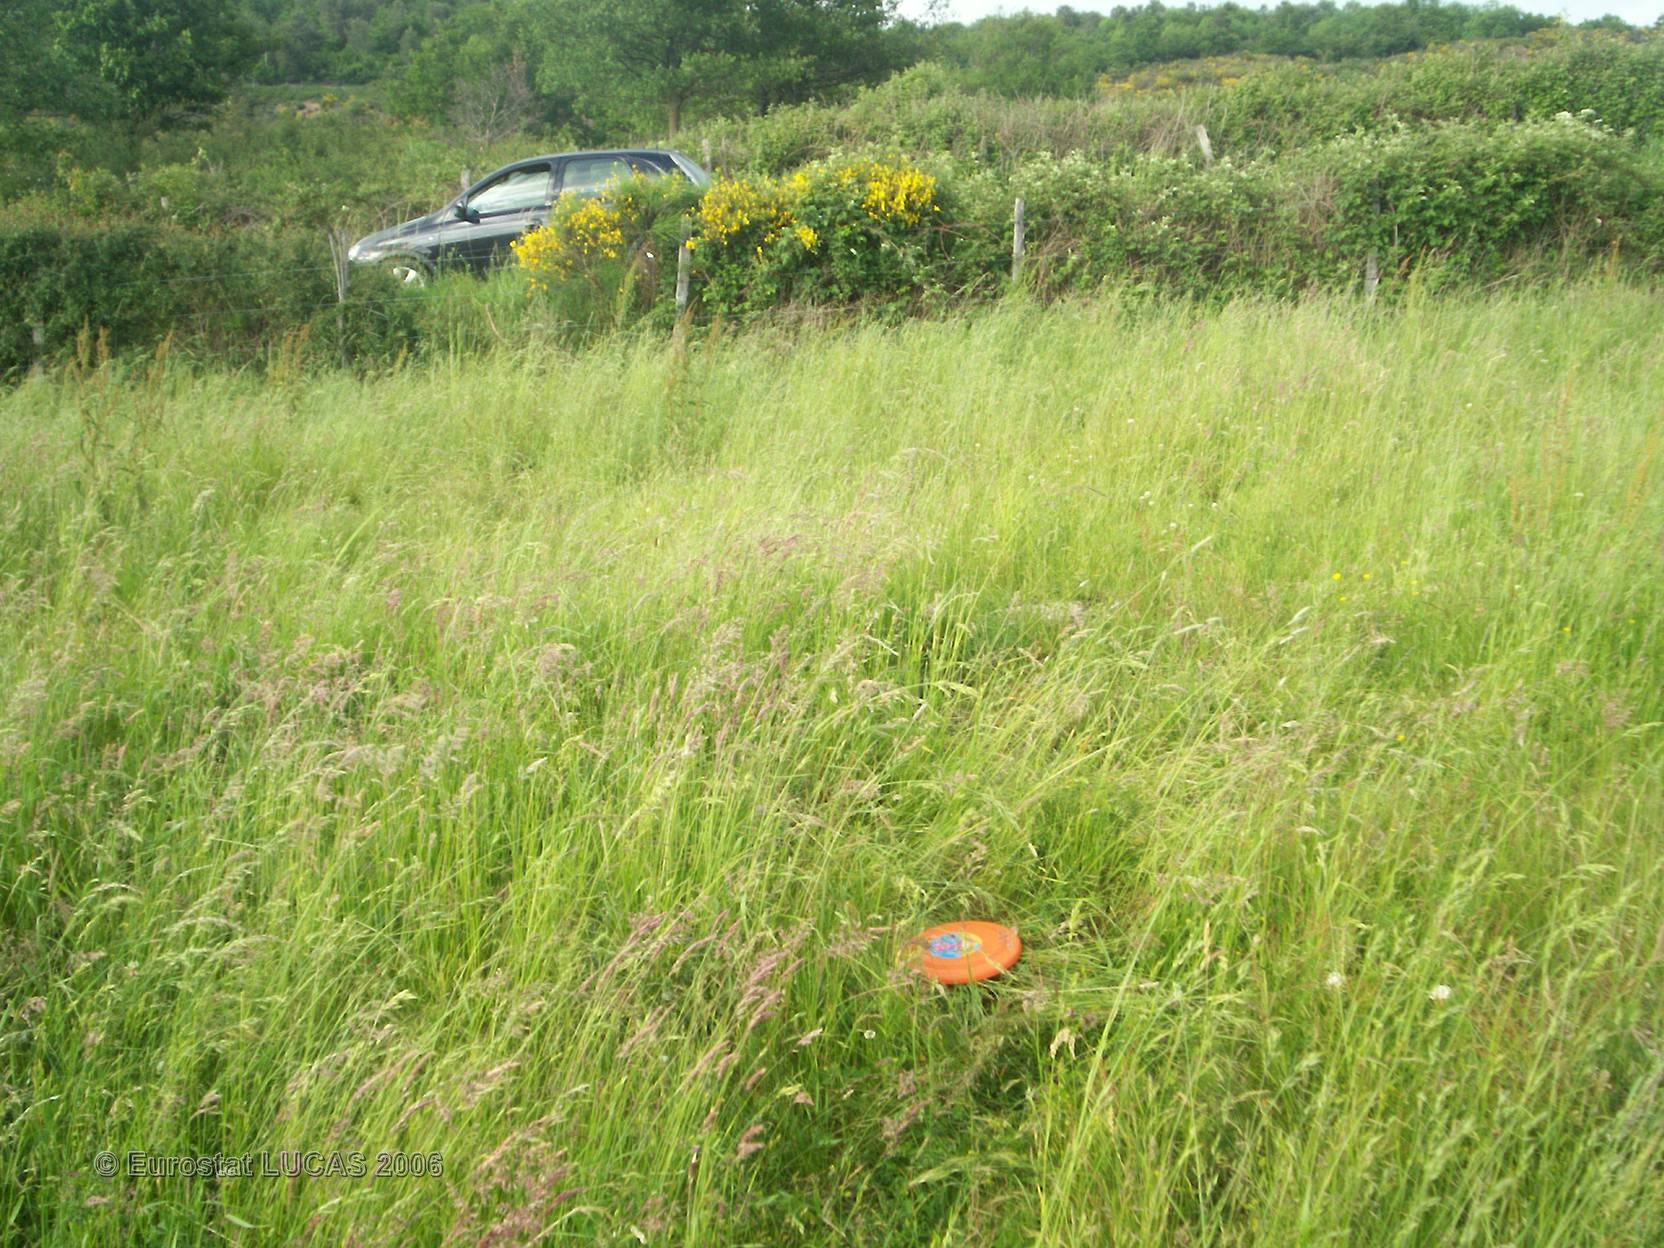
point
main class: Grassland
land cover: Grassland without tree/shrub cover
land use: Agriculture (excluding fallow land and kitchen gardens)
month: June
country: FR
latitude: 46.1121
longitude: 3.1284
